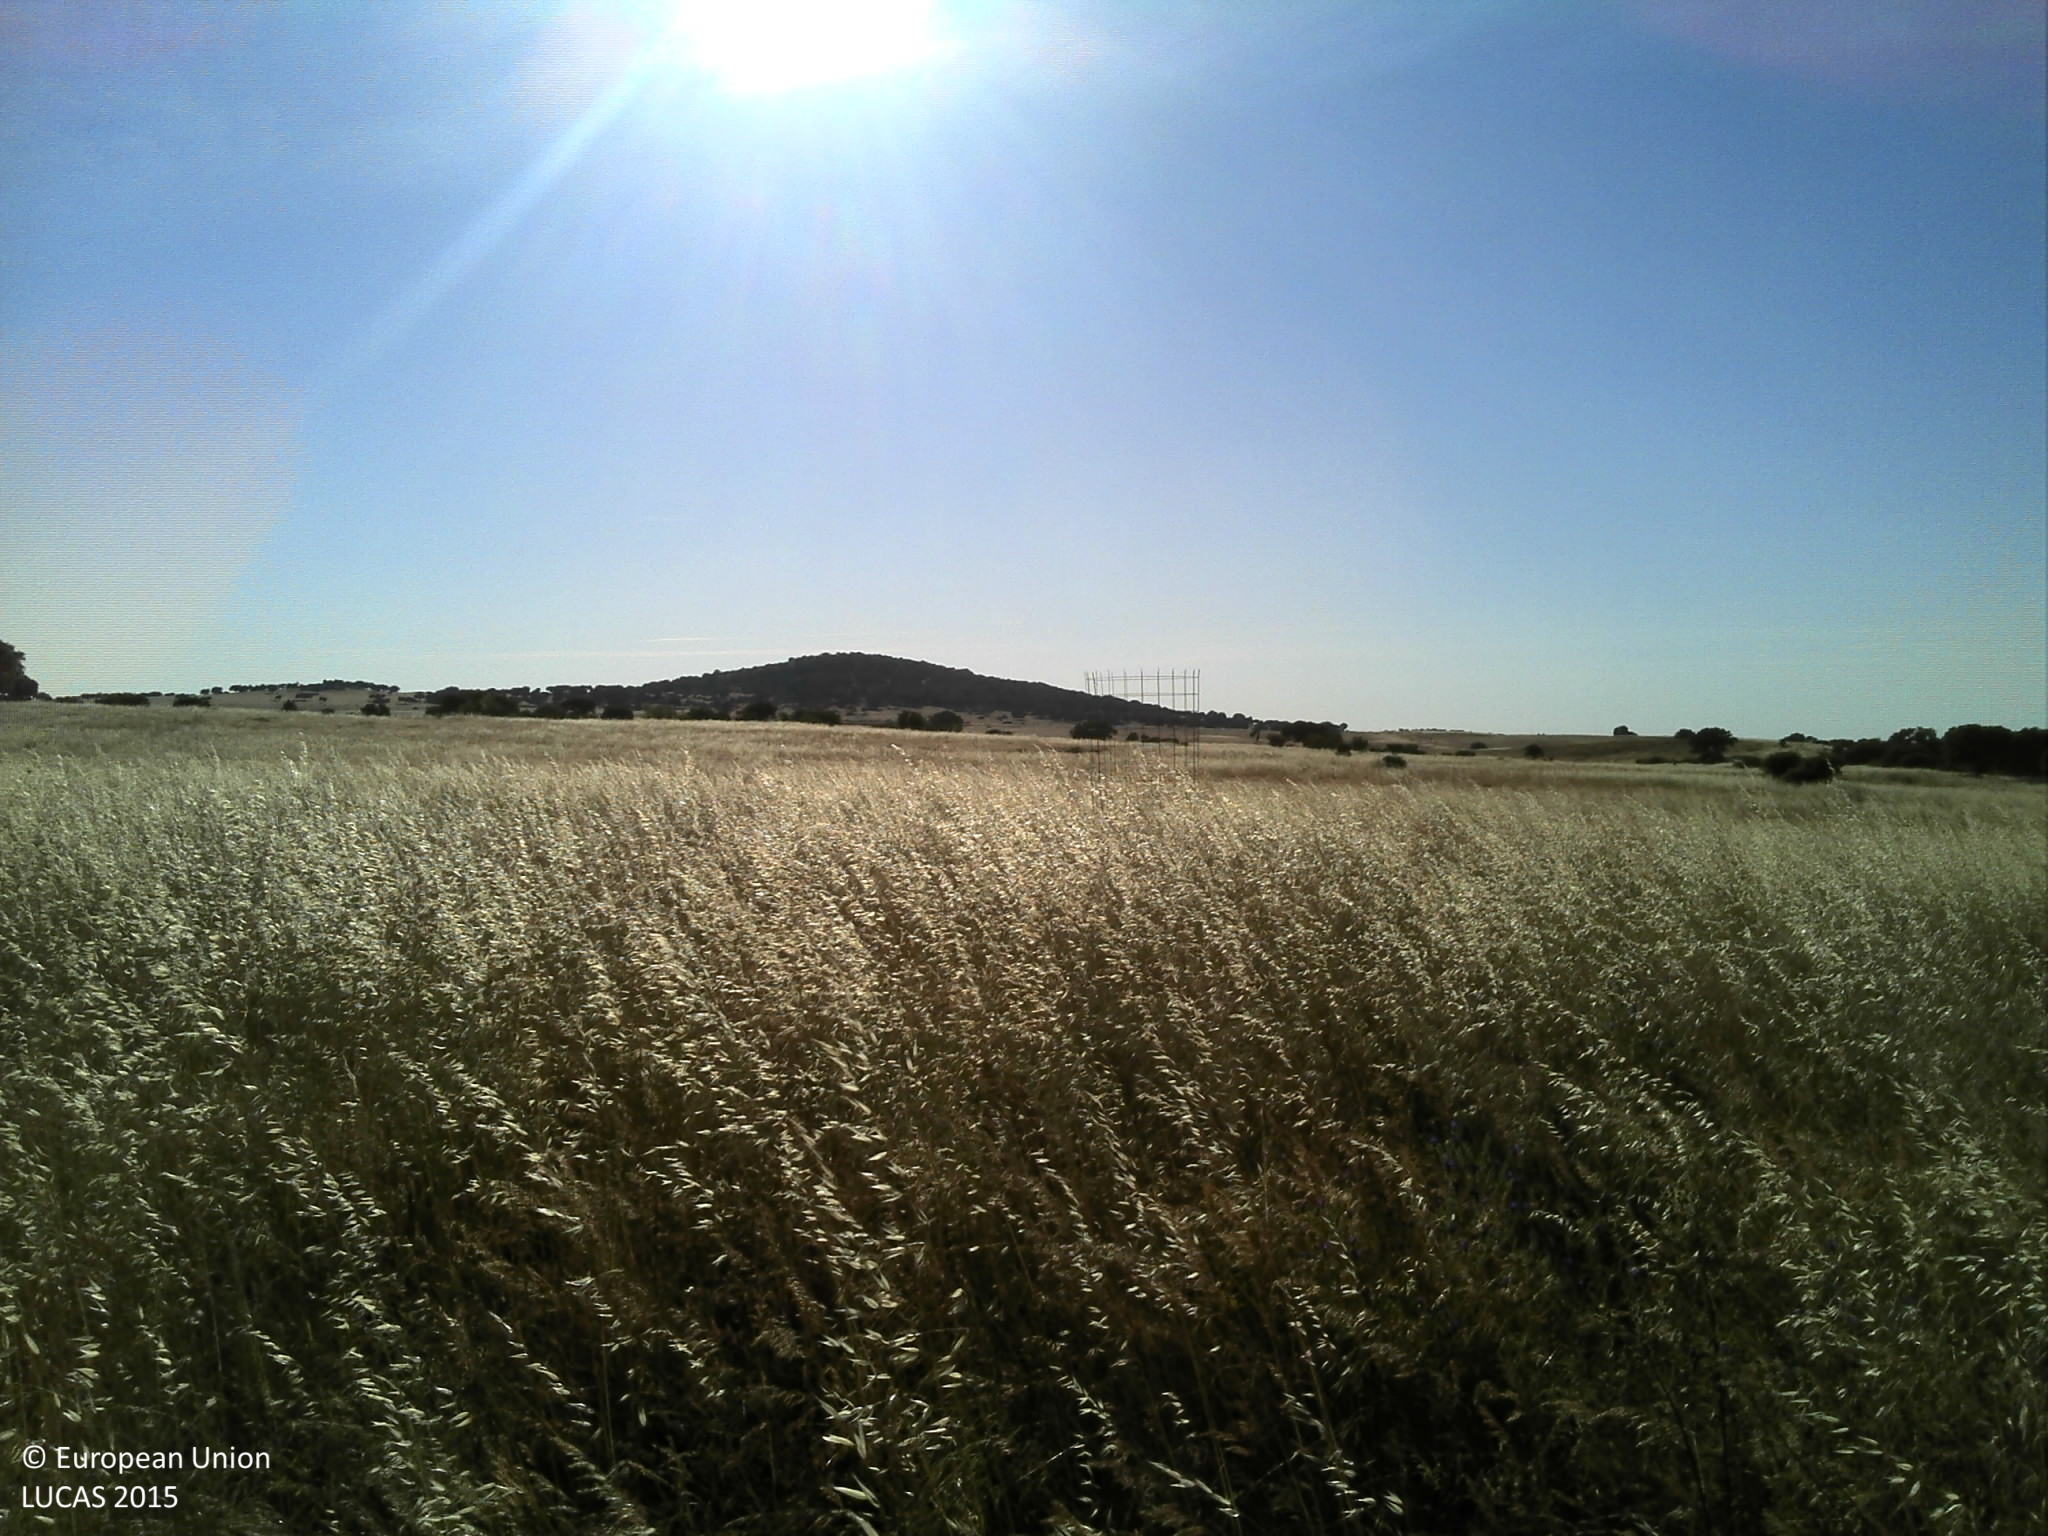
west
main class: Grassland
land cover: Grassland with sparse tree/shrub cover
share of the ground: > 75 %
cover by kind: herbaceous plants 90 %, broadleaved forest trees 5 %, unconsolidated bare surface 5 %
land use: Agriculture (excluding fallow land and kitchen gardens)
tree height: < 5 m
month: May
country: PT
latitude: 39.2312
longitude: -7.6185
